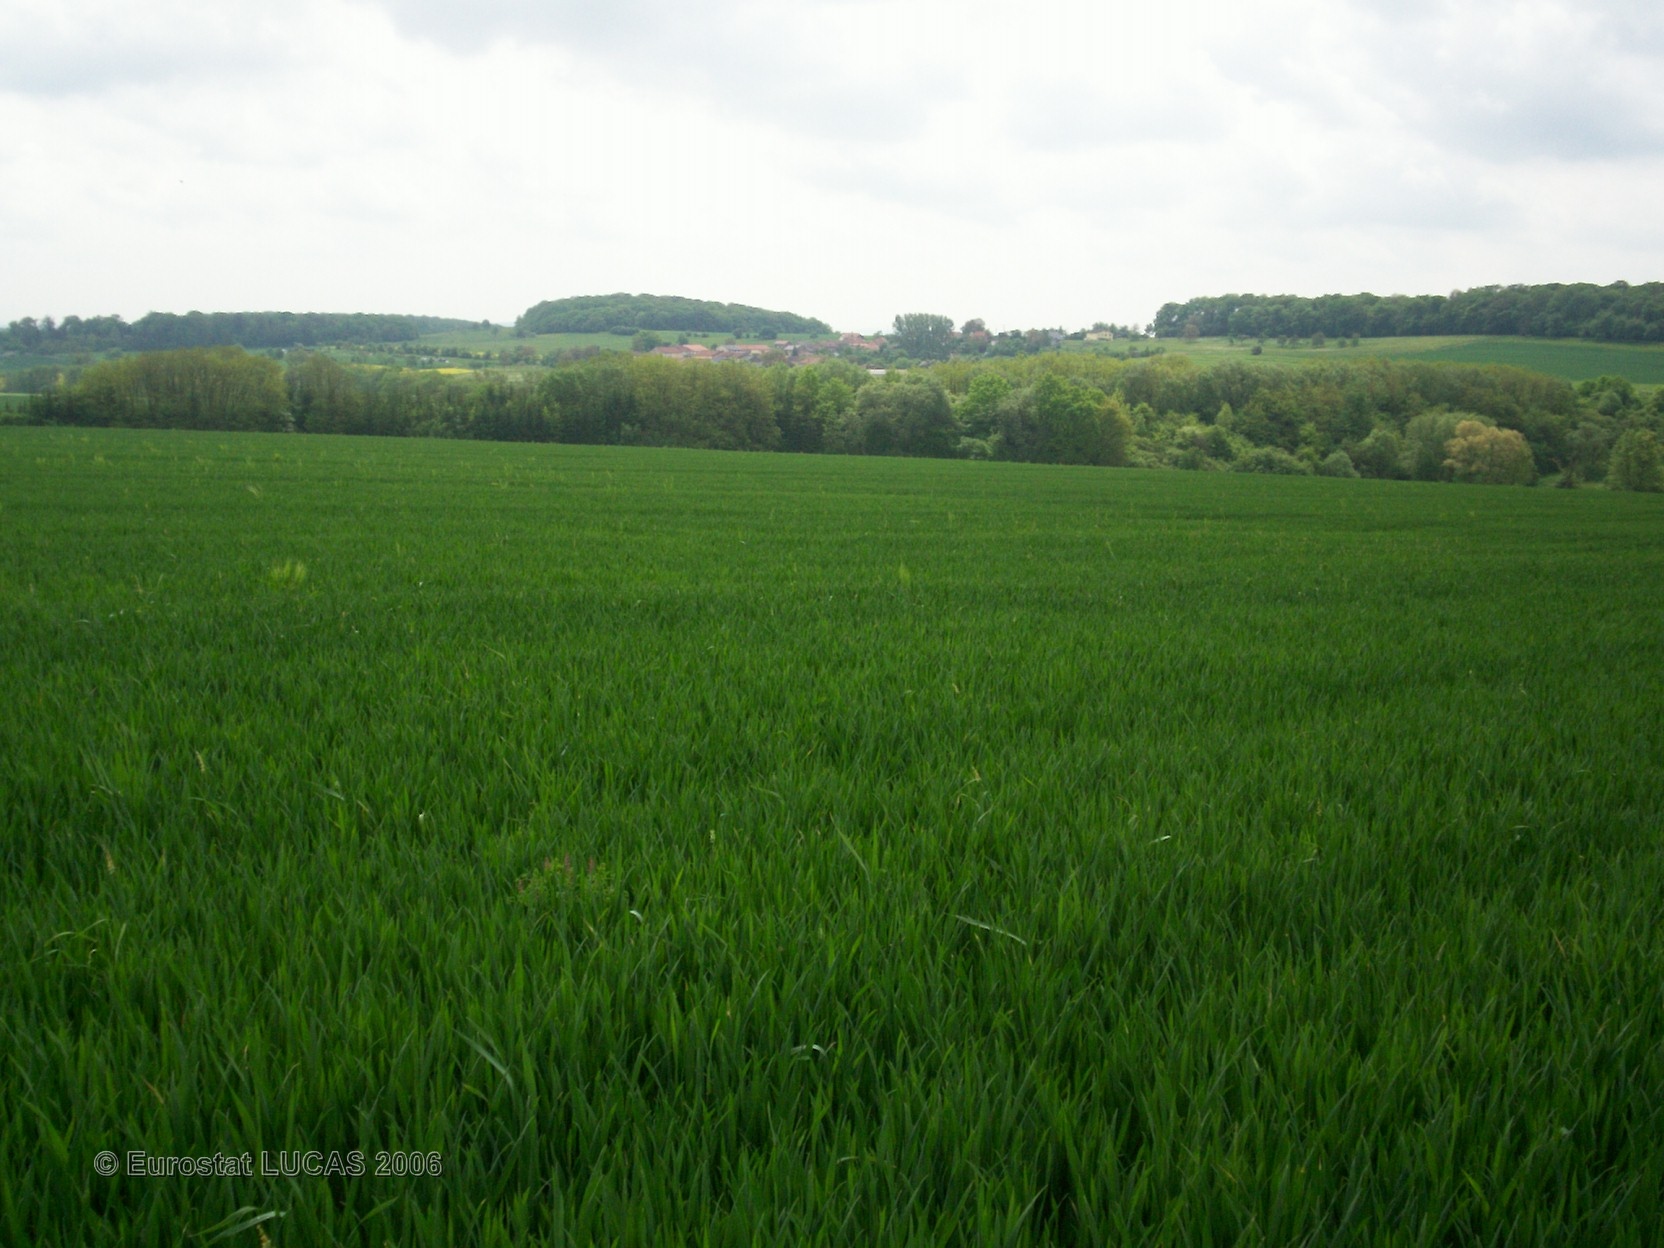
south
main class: Cropland
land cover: Common wheat
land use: Agriculture (excluding fallow land and kitchen gardens)
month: May
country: FR
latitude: 49.3929
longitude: 6.5141
